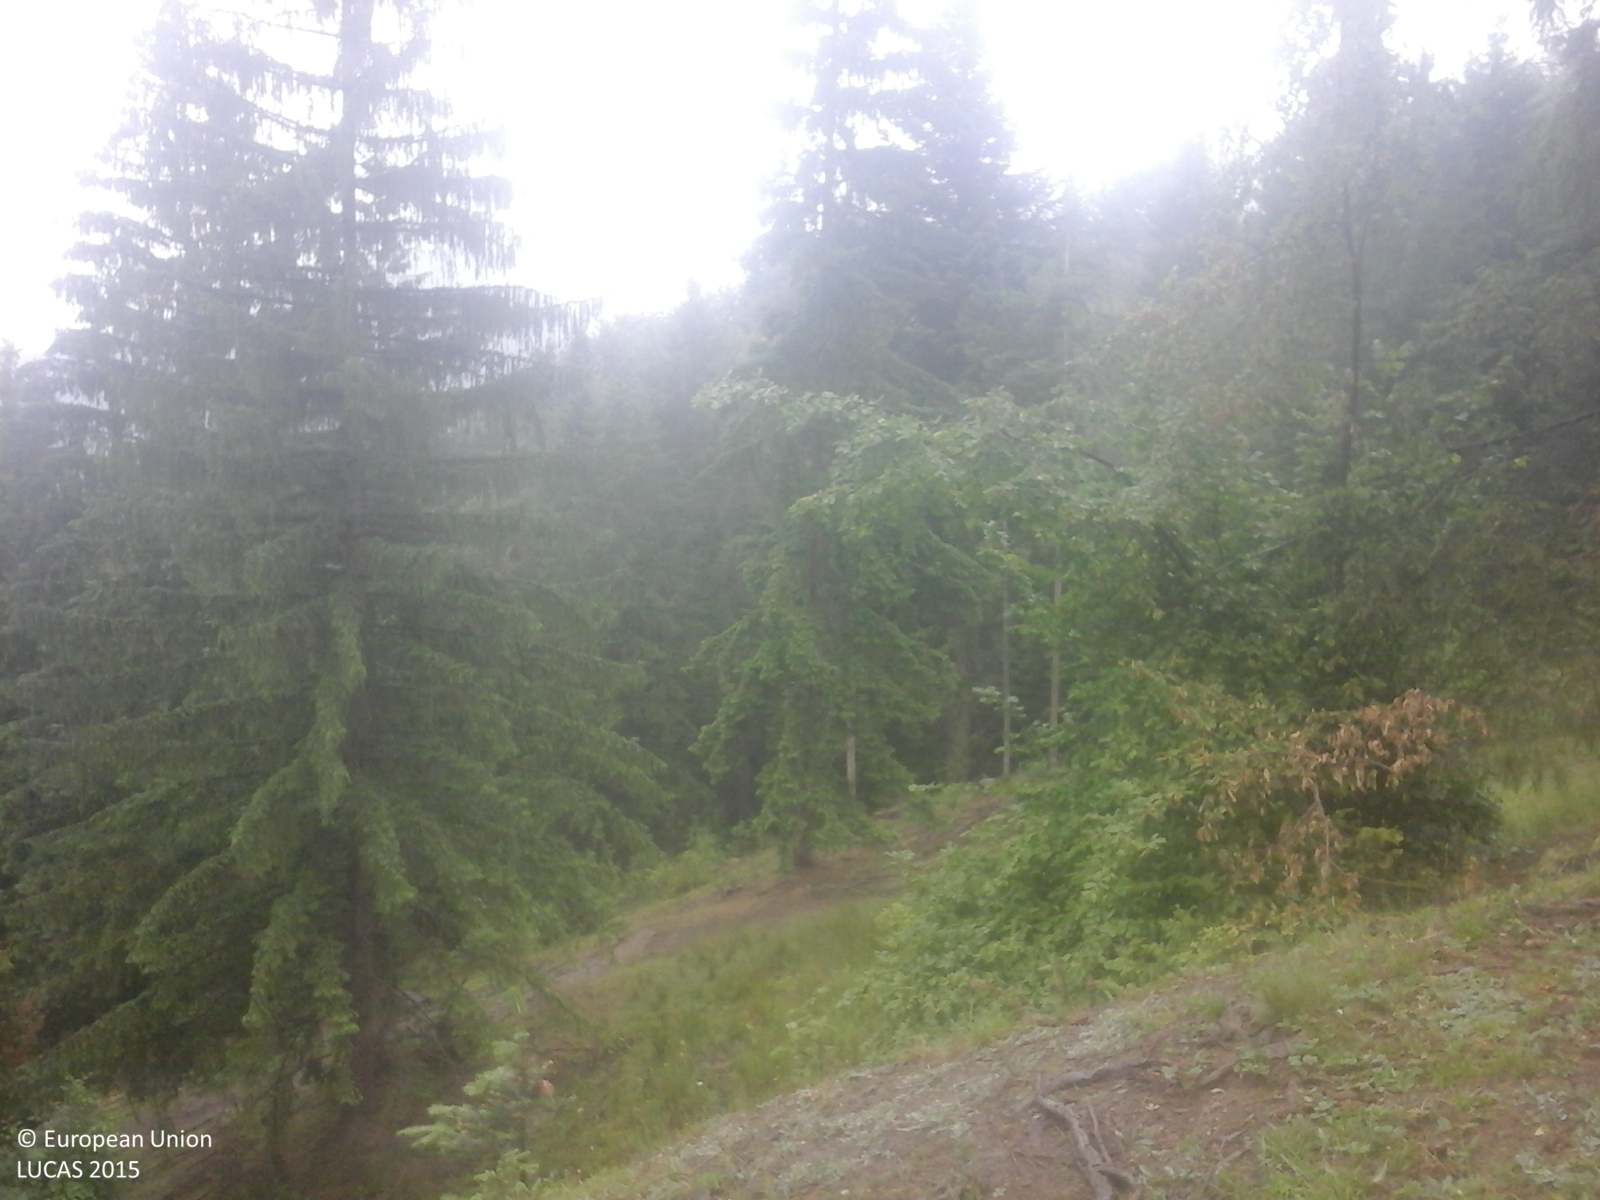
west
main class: Woodland
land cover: Spruce dominated coniferous woodland
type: alpine coniferous forest
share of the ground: > 75 %
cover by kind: coniferous forest trees 80 %, broadleaved forest trees 20 %
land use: Forestry
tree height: > 5 m
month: June
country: RO
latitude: 47.4322
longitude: 25.8621
